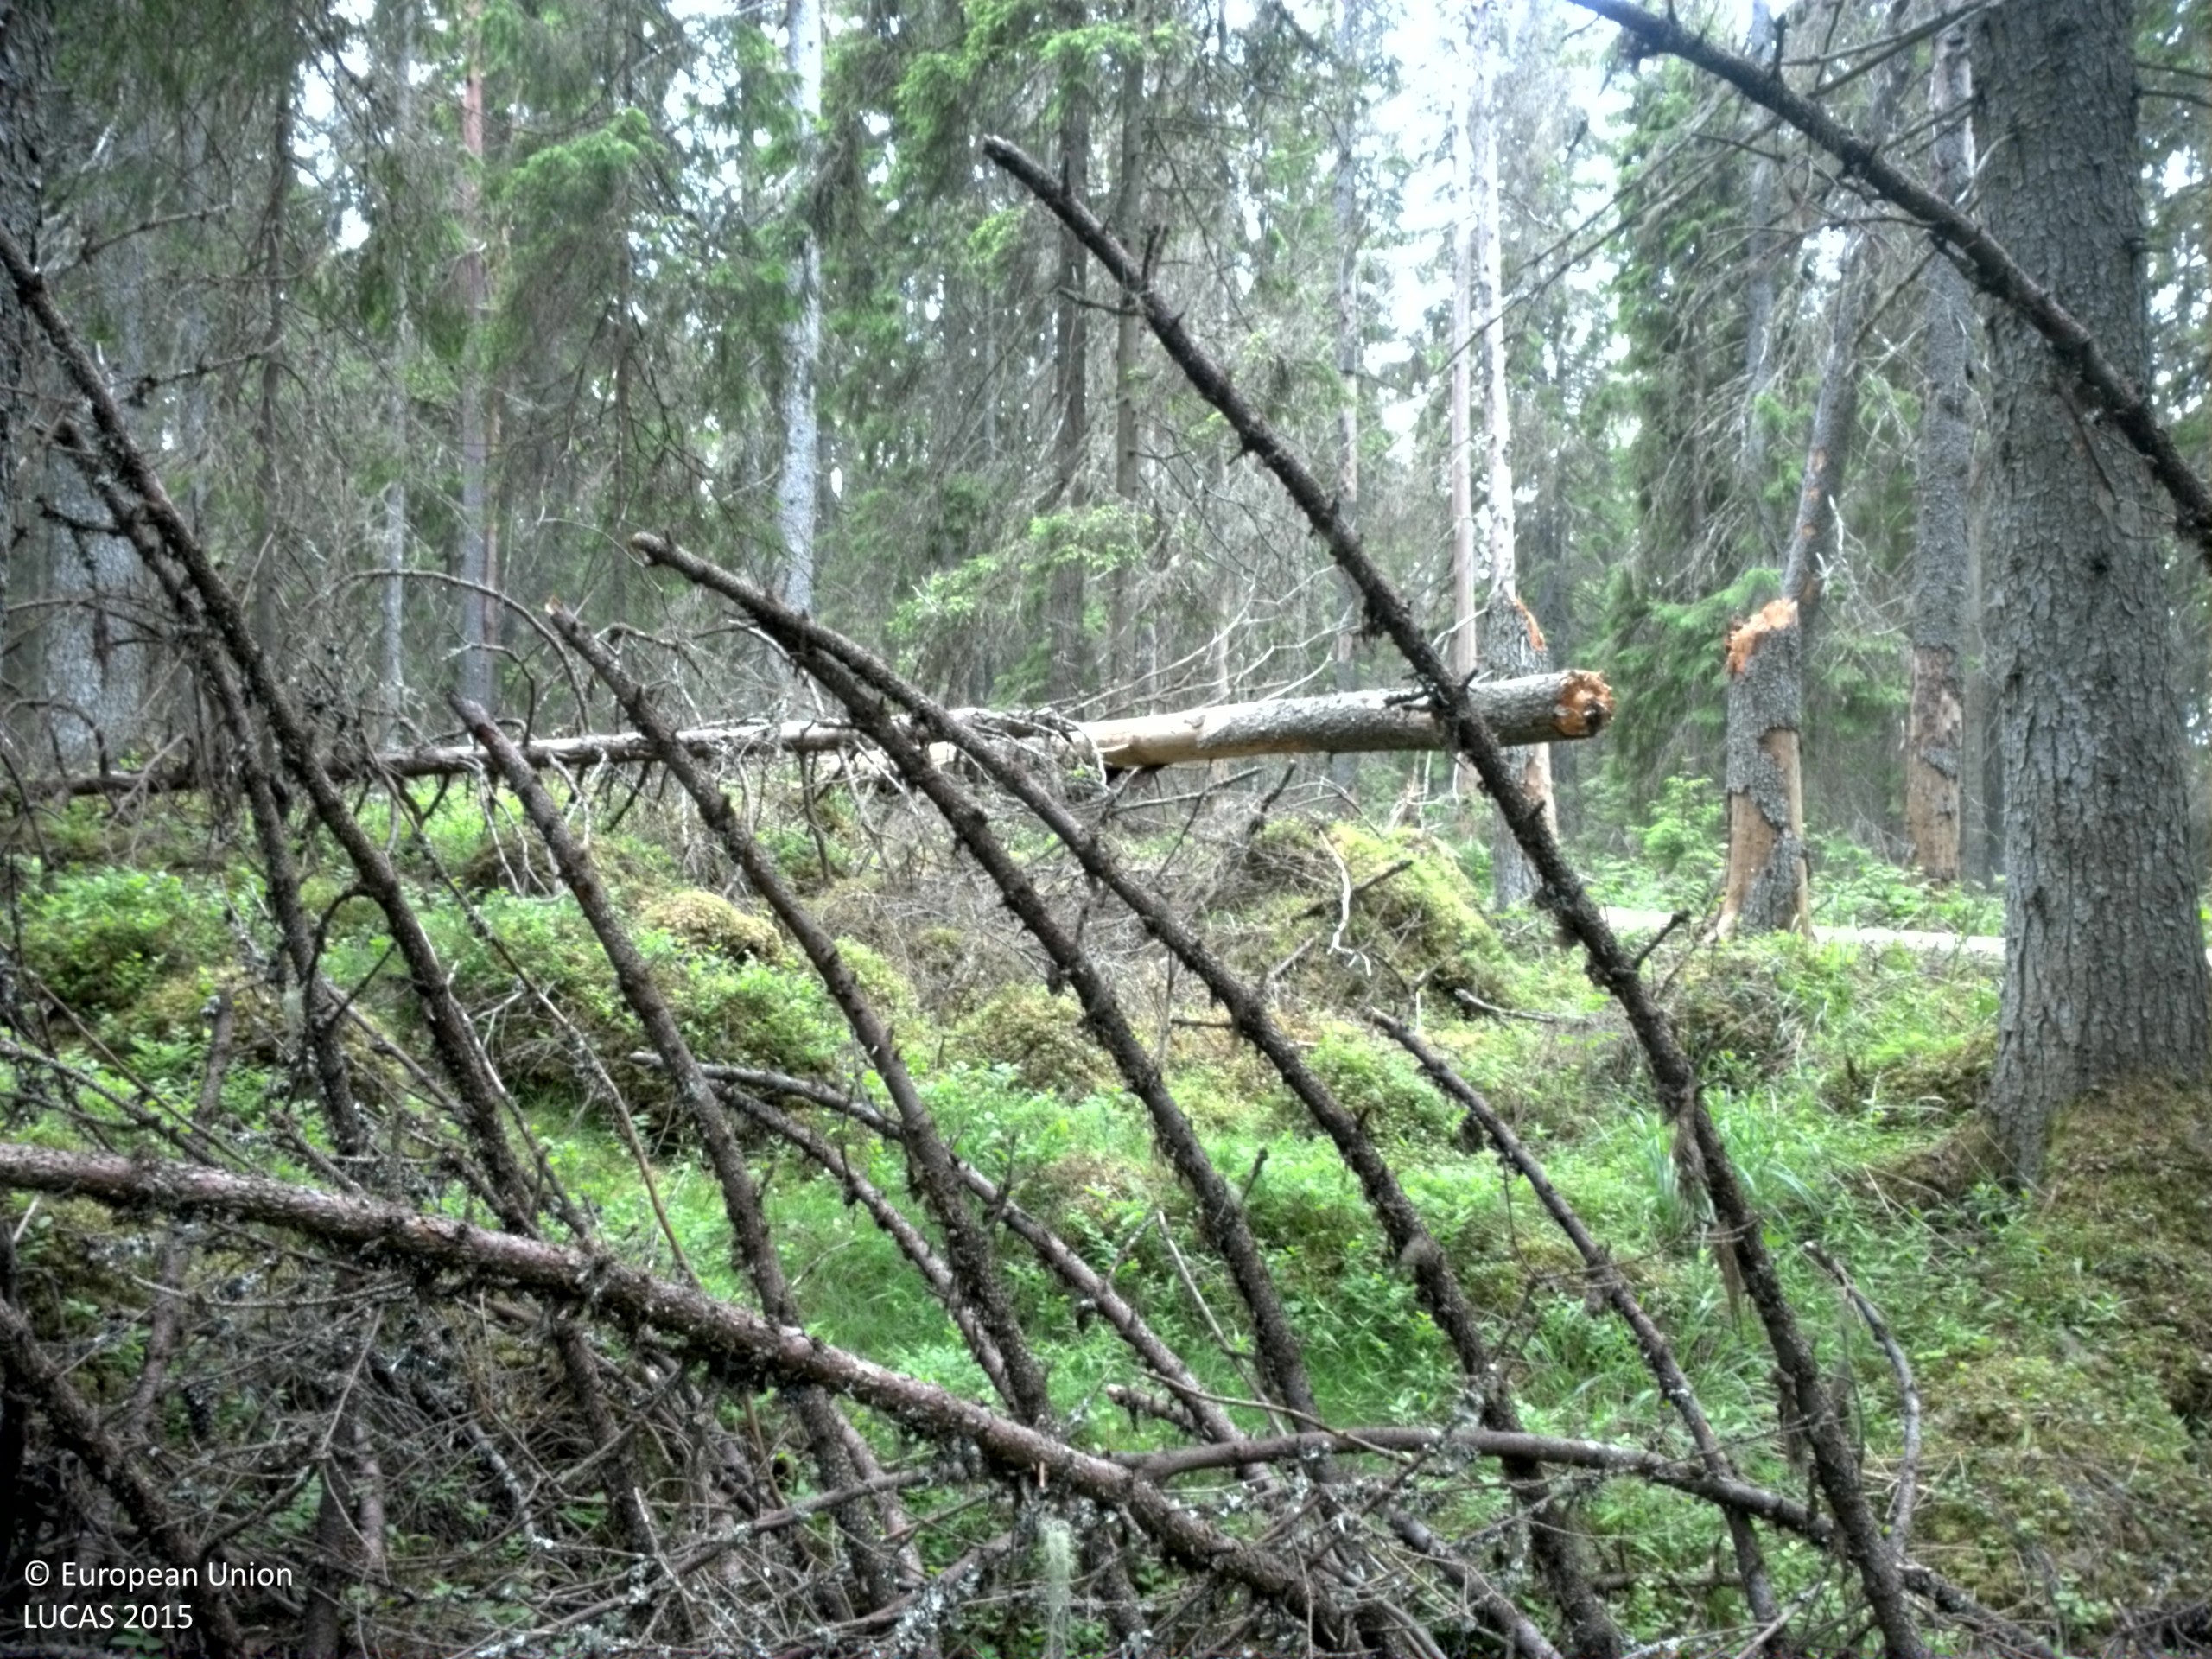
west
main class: Woodland
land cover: Spruce dominated coniferous woodland
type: boreal forest
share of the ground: > 75 %
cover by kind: coniferous forest trees 75 %, shrubs 10 %, lichens and mosses 10 %, broadleaved forest trees 5 %
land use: Forestry
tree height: > 5 m
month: June
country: SE
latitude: 60.3109
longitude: 17.7577
